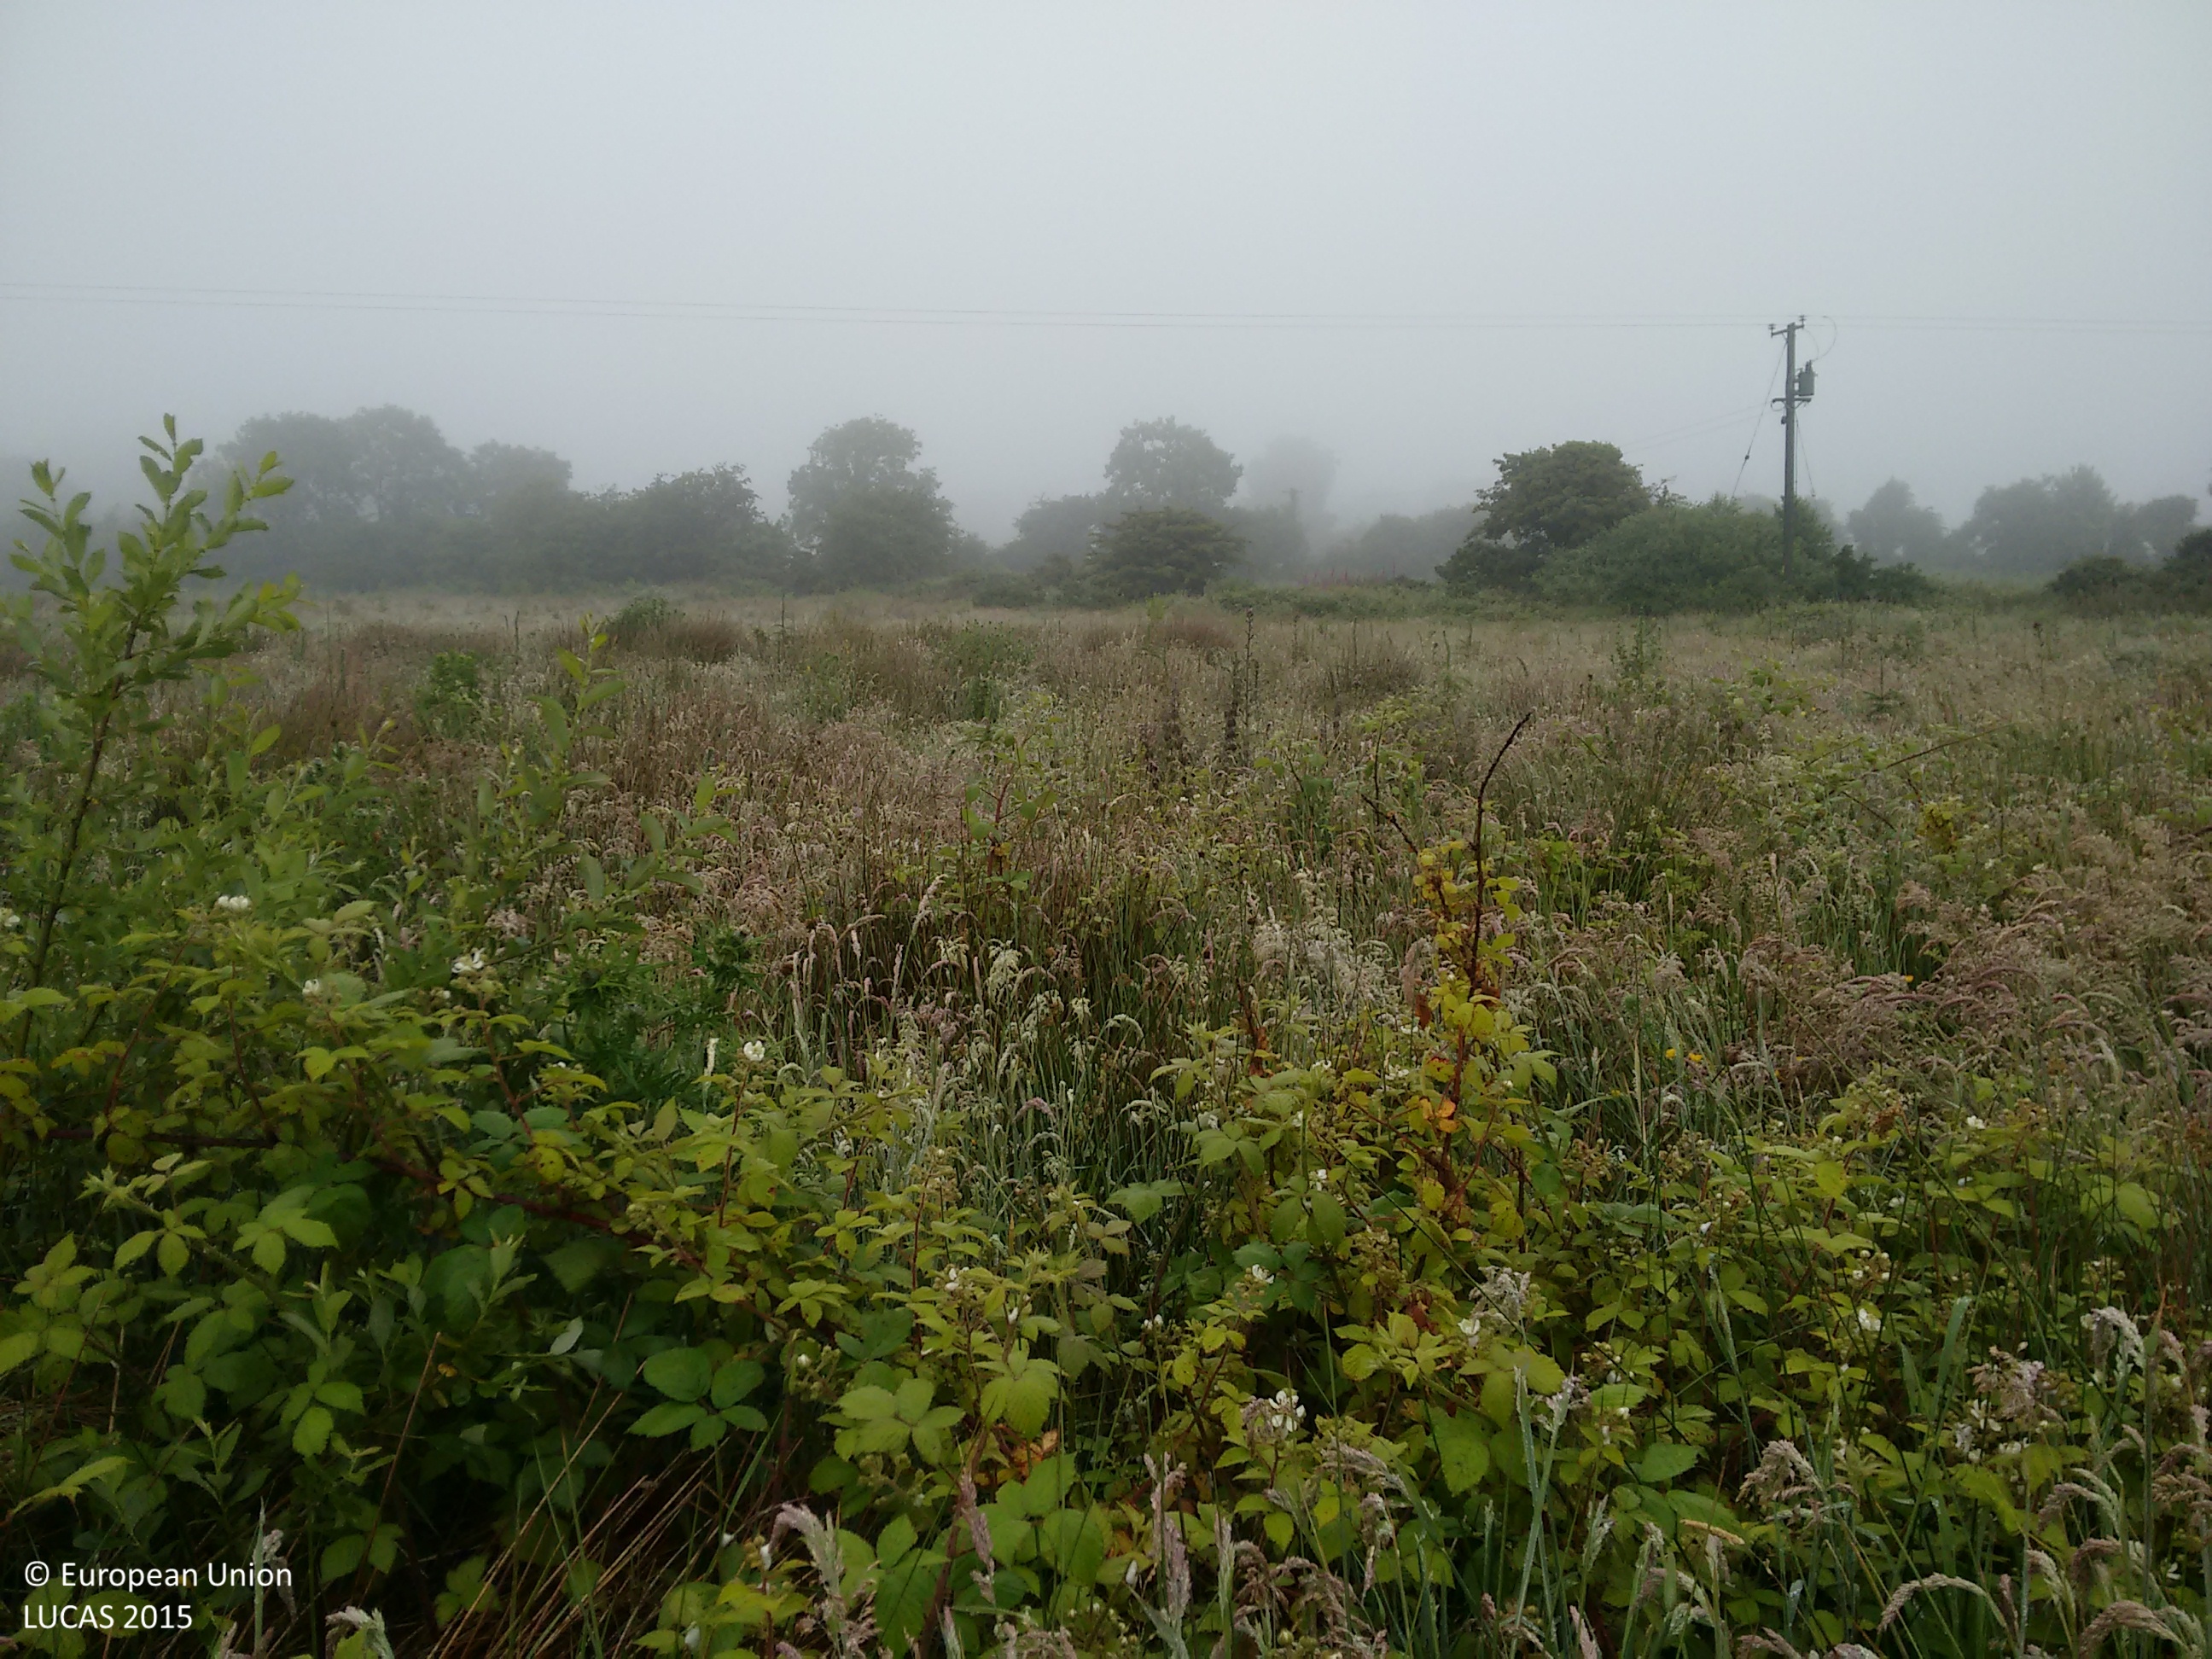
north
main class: Grassland
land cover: Spontaneously vegetated surfaces
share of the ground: > 75 %
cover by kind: herbaceous plants 95 %, shrubs 5 %
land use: Semi-natural and natural areas not in use
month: June
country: IE
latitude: 52.4039
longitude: -7.2757
